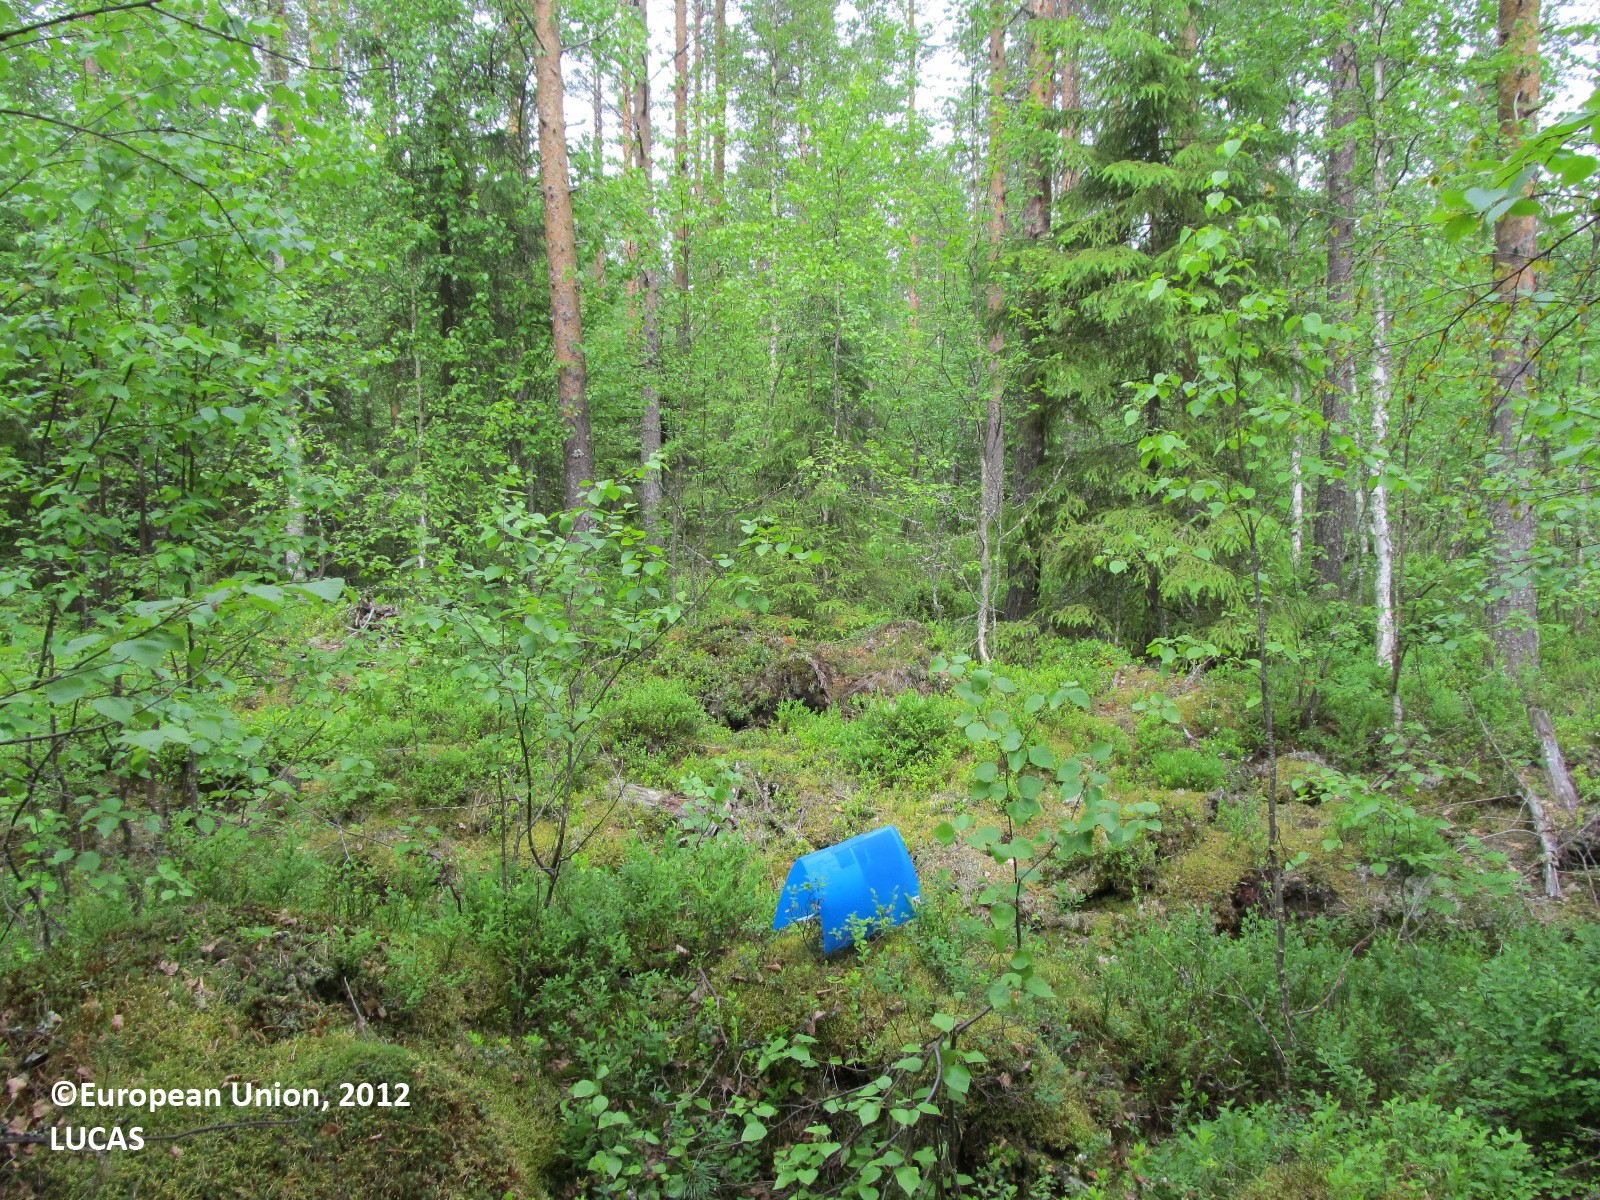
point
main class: Woodland
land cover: Pine dominated mixed woodland
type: boreal forest
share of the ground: 50 - 75 %
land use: Forestry
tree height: > 5 m
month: June
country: FI
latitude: 62.8211
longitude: 28.9958
